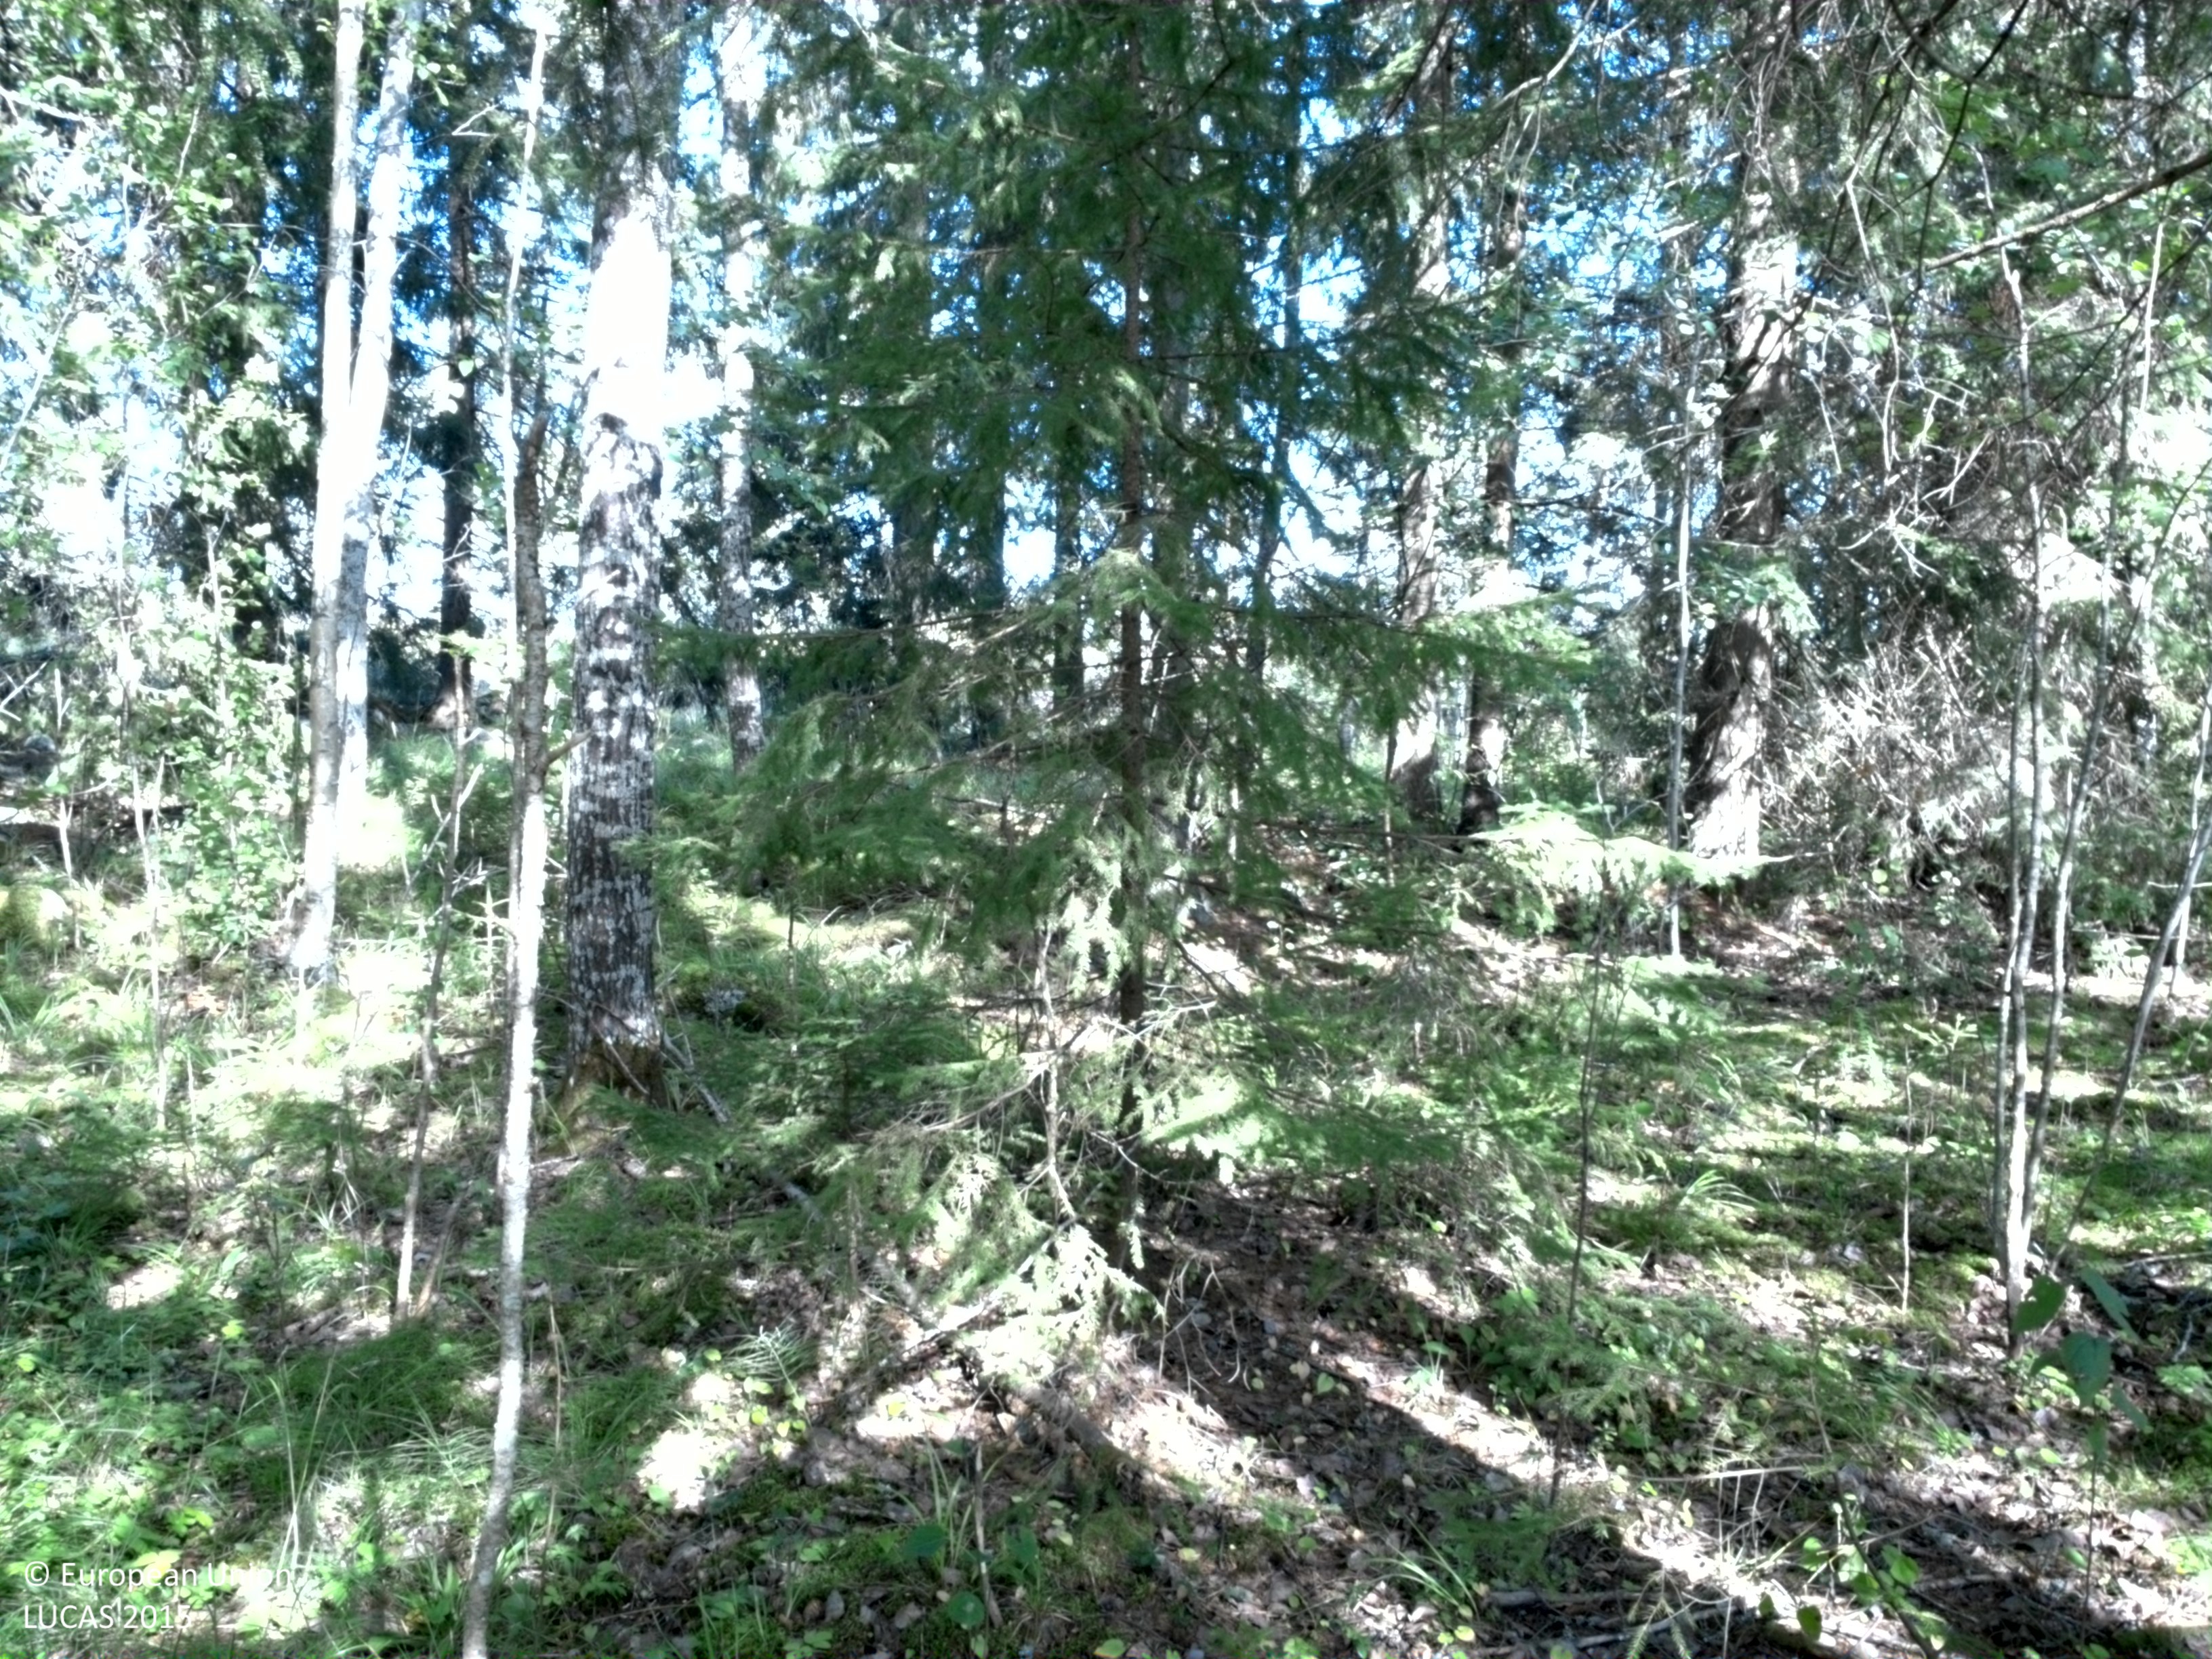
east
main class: Woodland
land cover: Spruce dominated mixed woodland
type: boreal forest
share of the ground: > 75 %
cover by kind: coniferous forest trees 60 %, broadleaved forest trees 20 %, herbaceous plants 20 %
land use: Forestry
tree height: > 5 m
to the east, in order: Spruce dominated mixed woodland; Railways; Broadleaved woodland; Spruce dominated mixed woodland
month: August
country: SE
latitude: 59.9769
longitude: 16.4948
